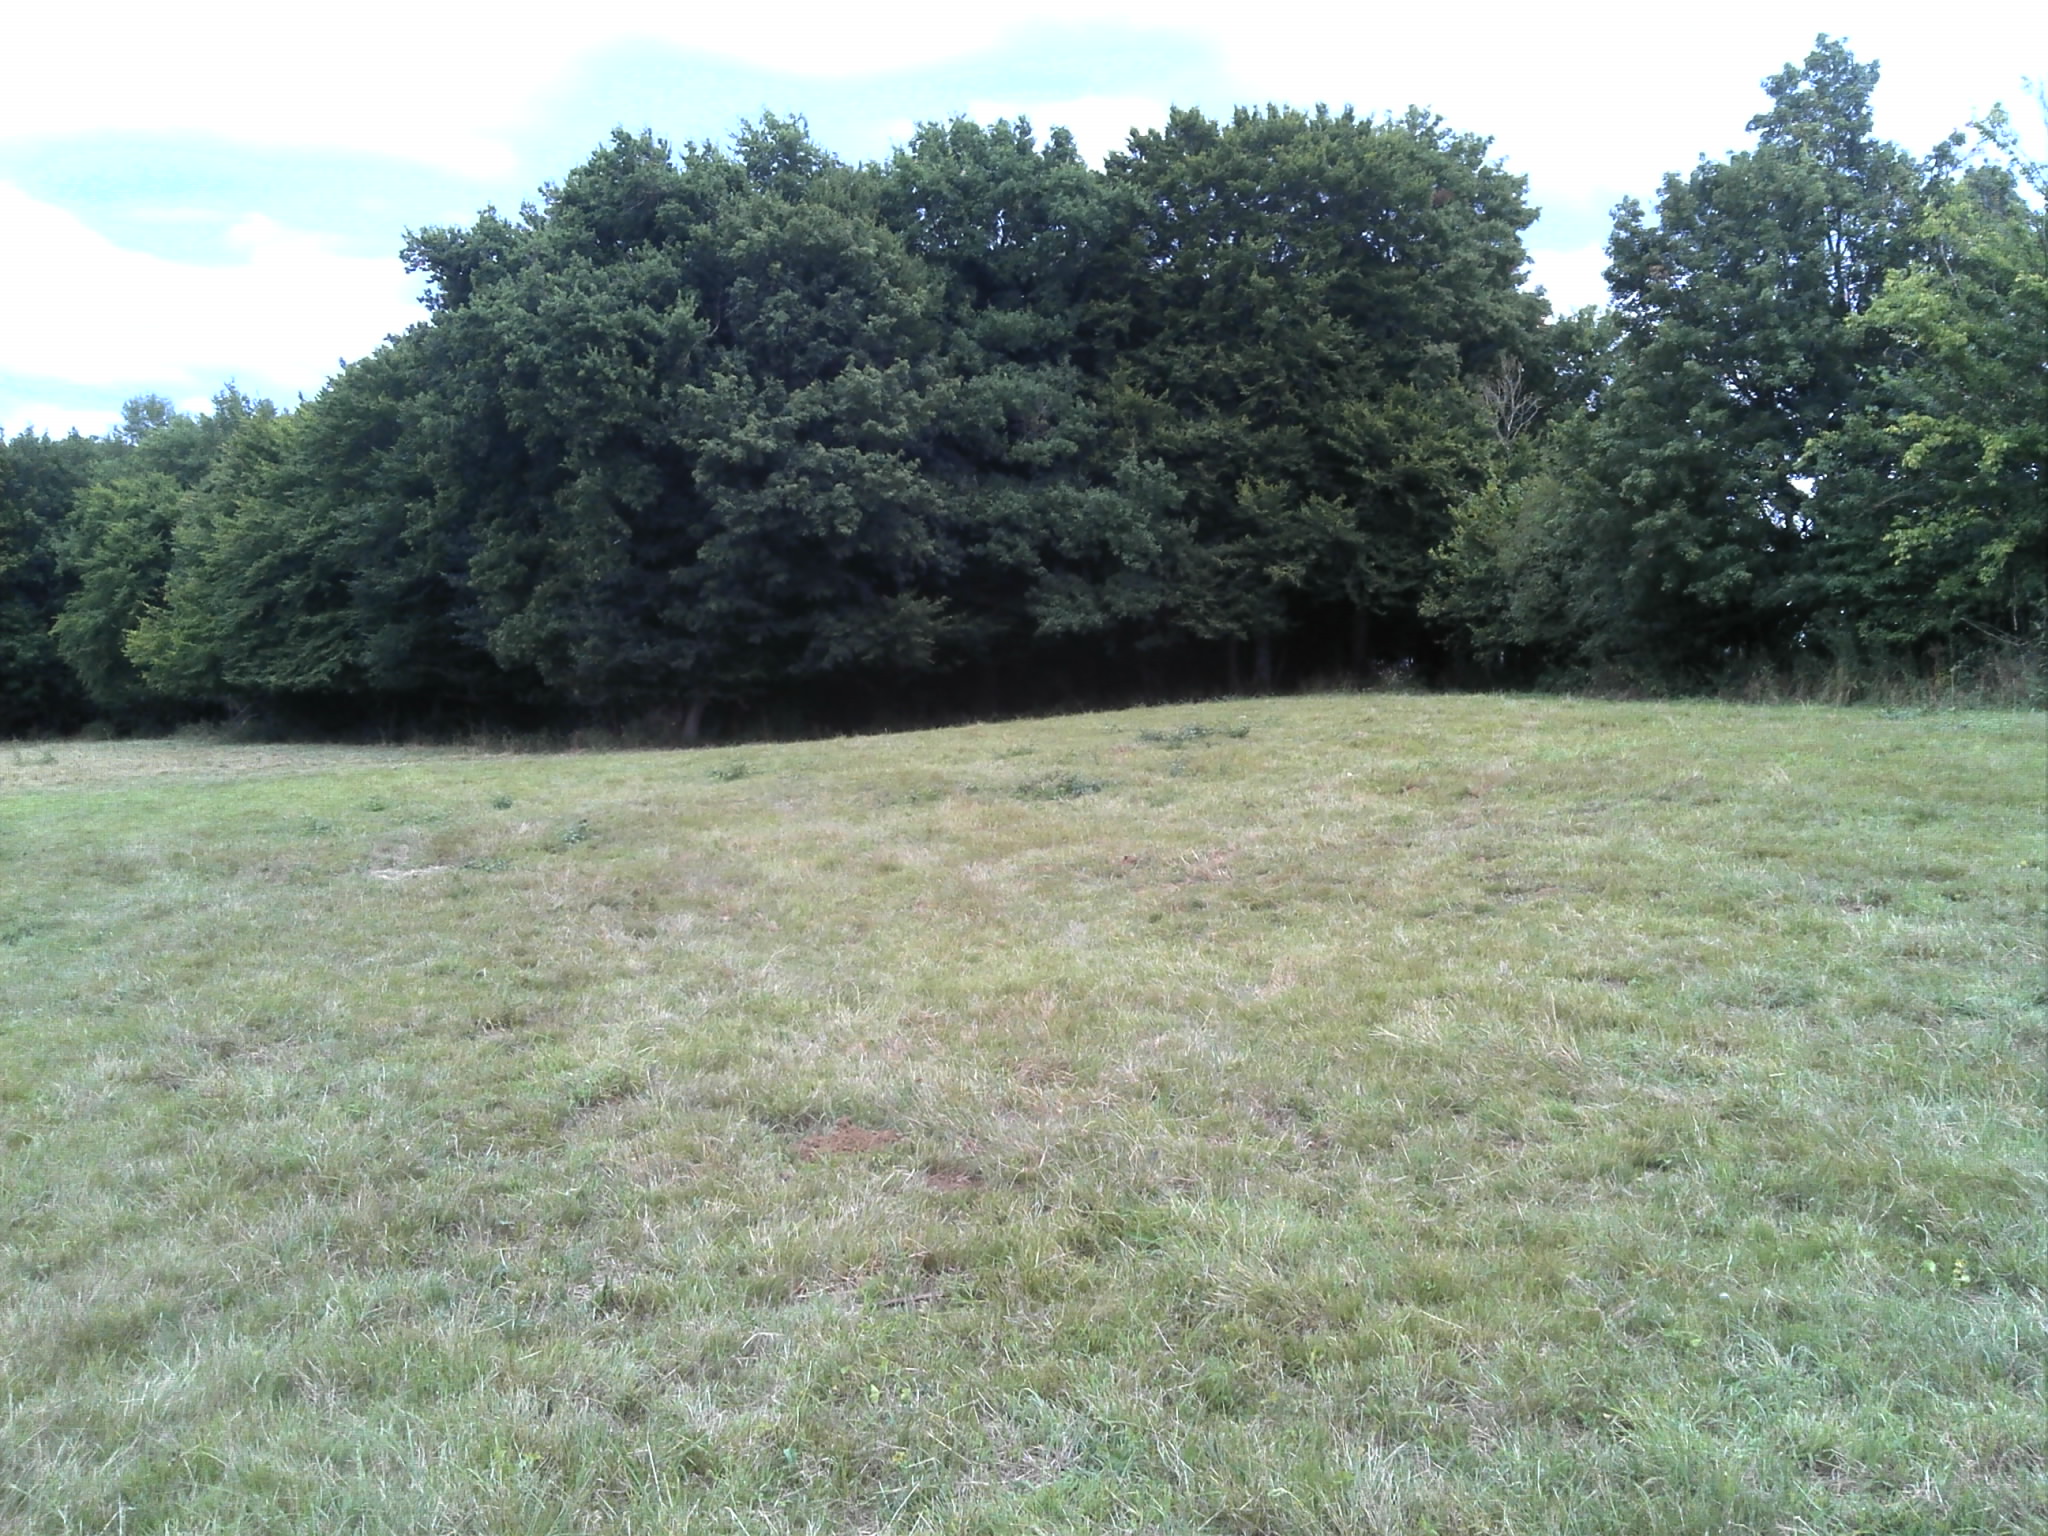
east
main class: Grassland
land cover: Grassland with sparse tree/shrub cover
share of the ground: > 75 %
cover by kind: herbaceous plants 95 %, broadleaved forest trees 5 %
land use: Agriculture (excluding fallow land and kitchen gardens)
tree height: > 5 m
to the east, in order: Grassland with sparse tree/shrub cover; Fences; Broadleaved woodland; Fences; Grassland without tree/shrub cover
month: July
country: FR
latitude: 46.5217
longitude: 1.5298
